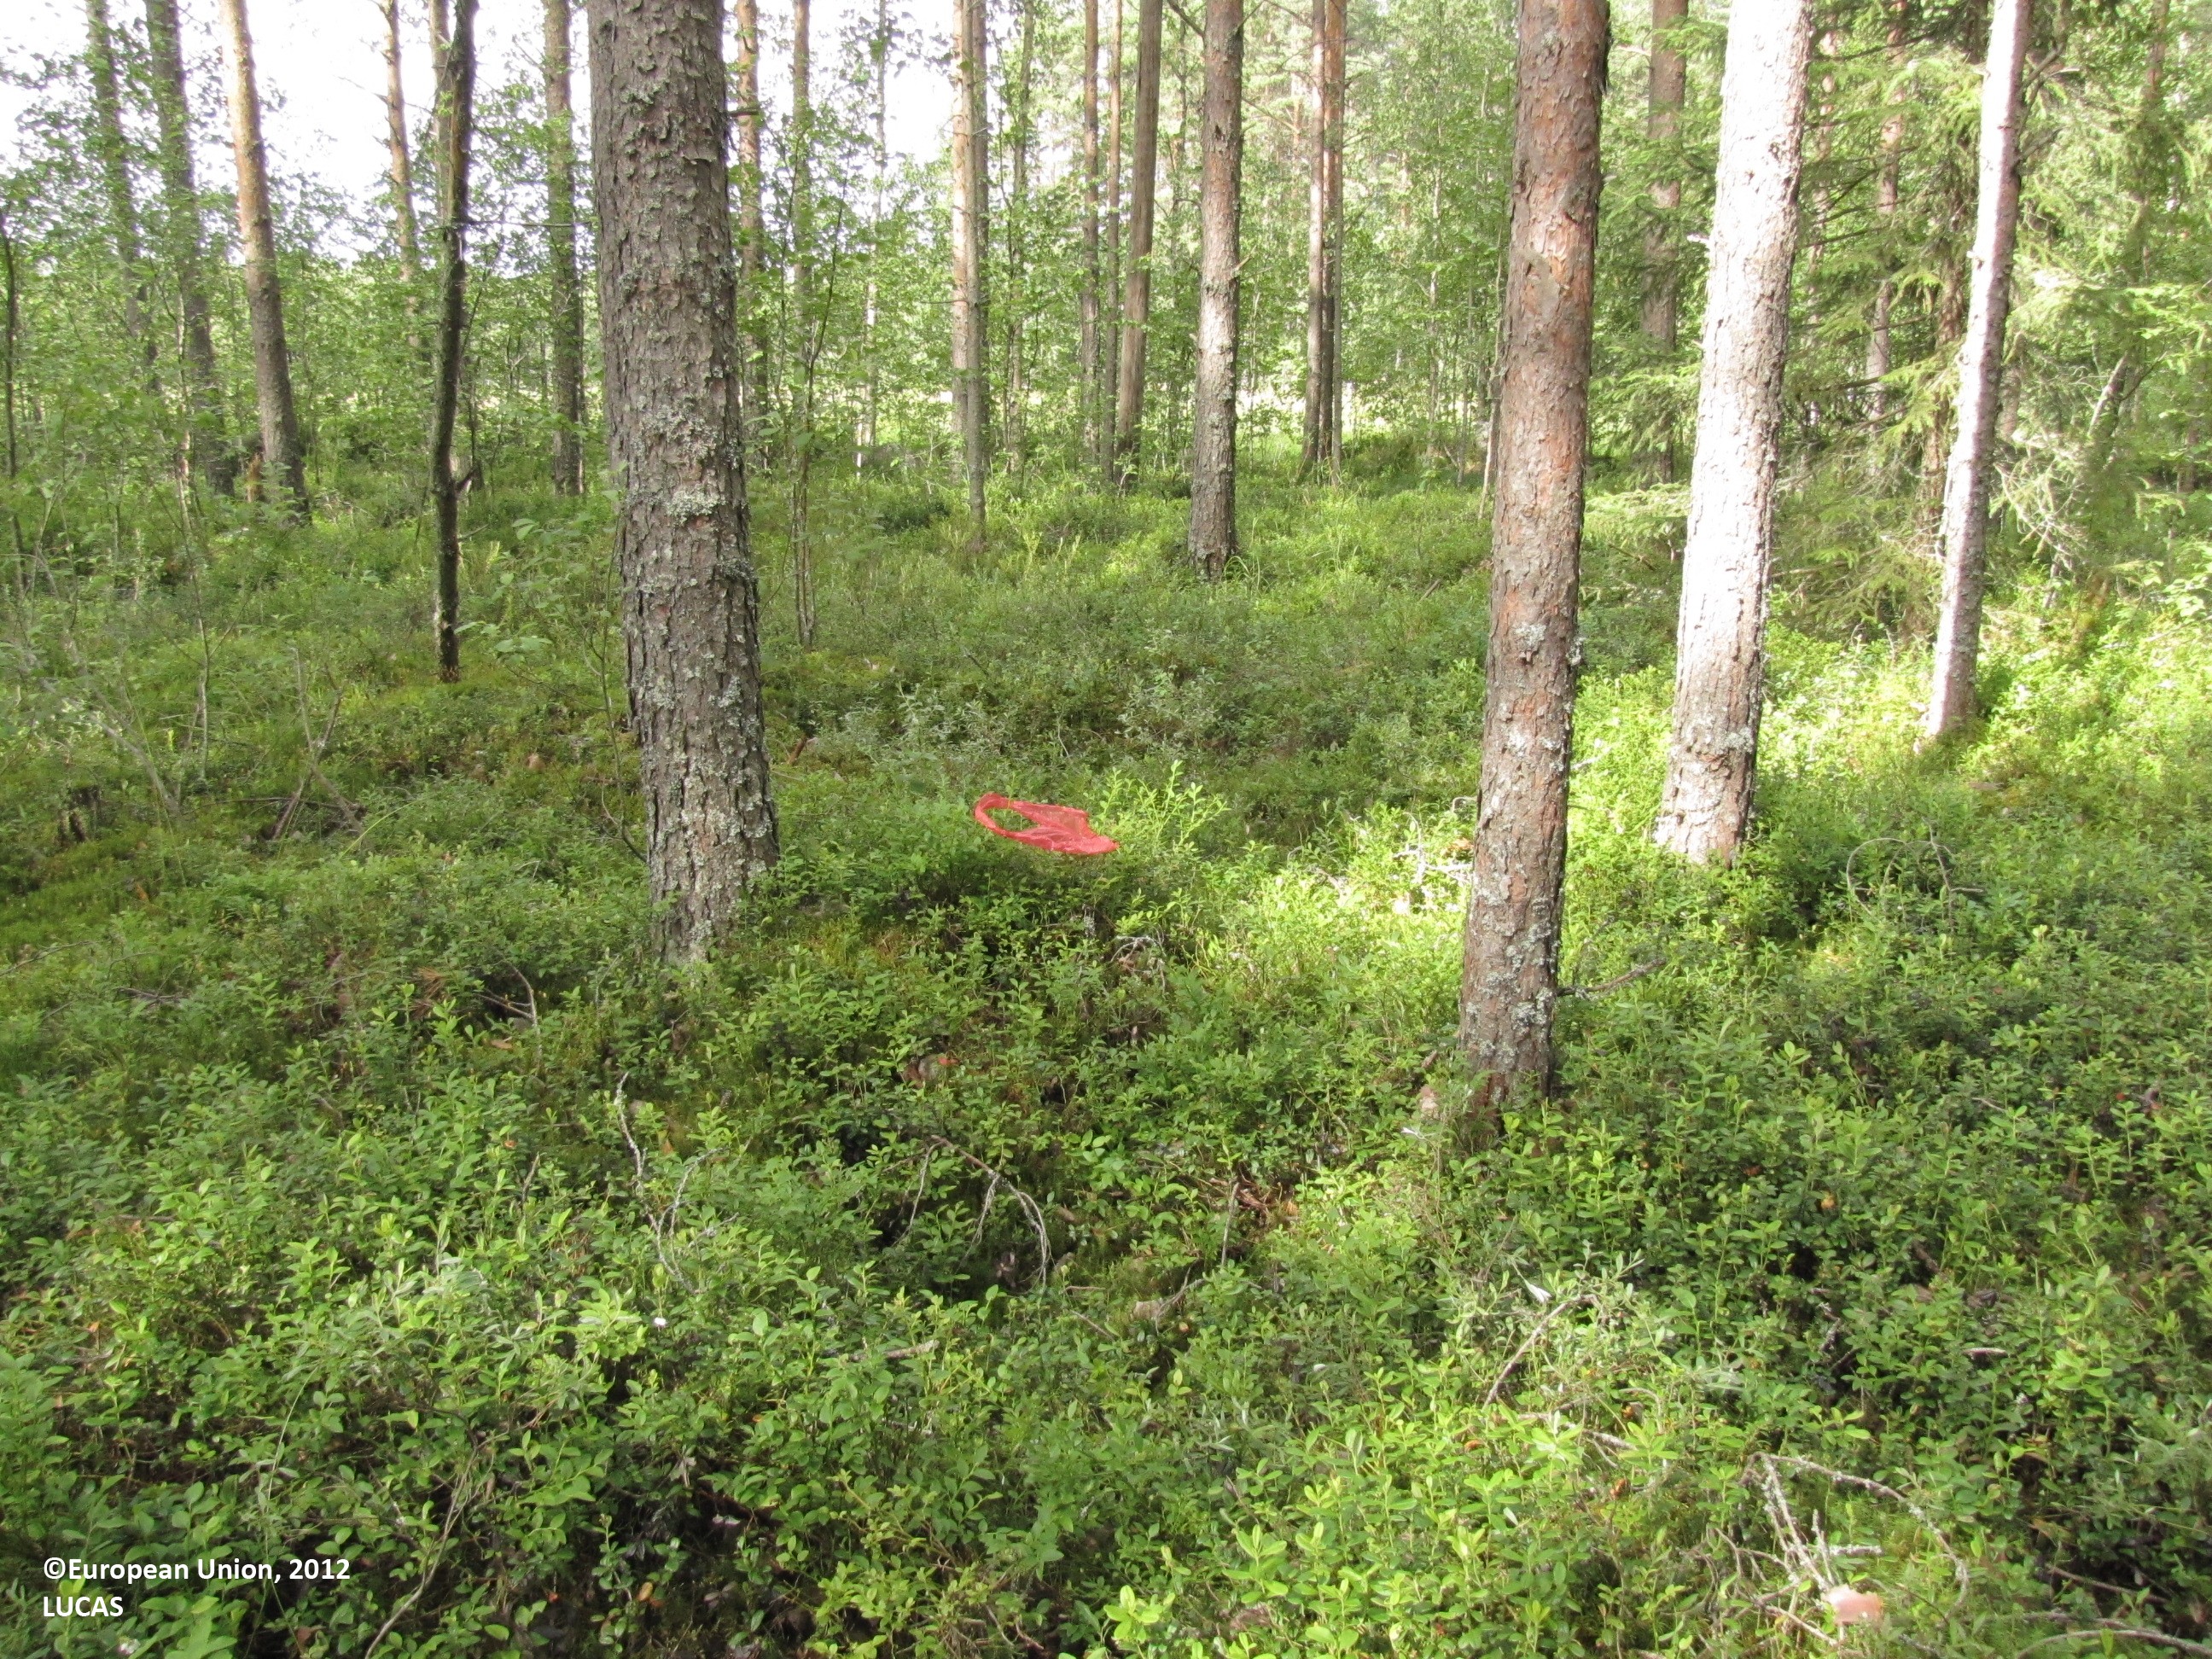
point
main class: Woodland
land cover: Pine dominated coniferous woodland
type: boreal forest
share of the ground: > 75 %
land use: Forestry
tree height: > 5 m
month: July
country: FI
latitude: 62.3171
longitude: 23.2466
